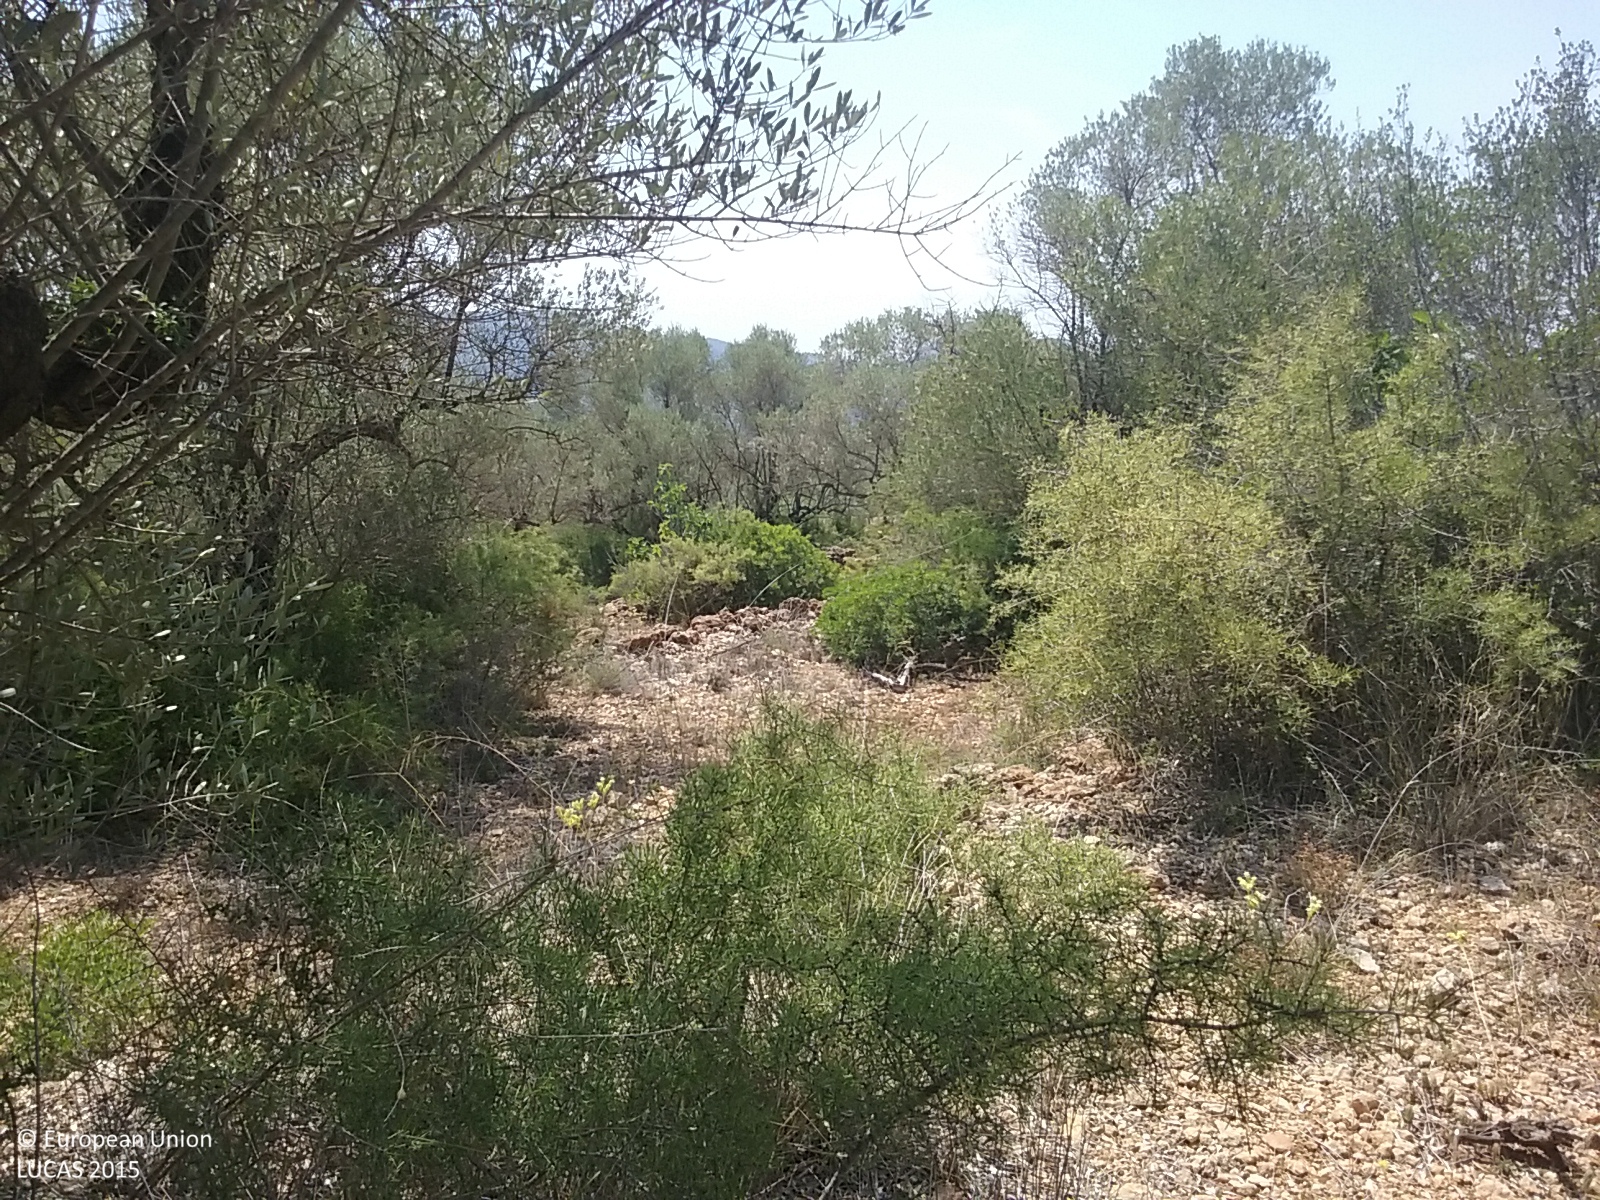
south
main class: Cropland
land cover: Olive groves
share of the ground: 25 - 50 %
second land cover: Grassland without tree/shrub cover
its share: 50 - 75 %
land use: Abandoned areas
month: July
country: ES
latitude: 40.1495
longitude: -0.0629
